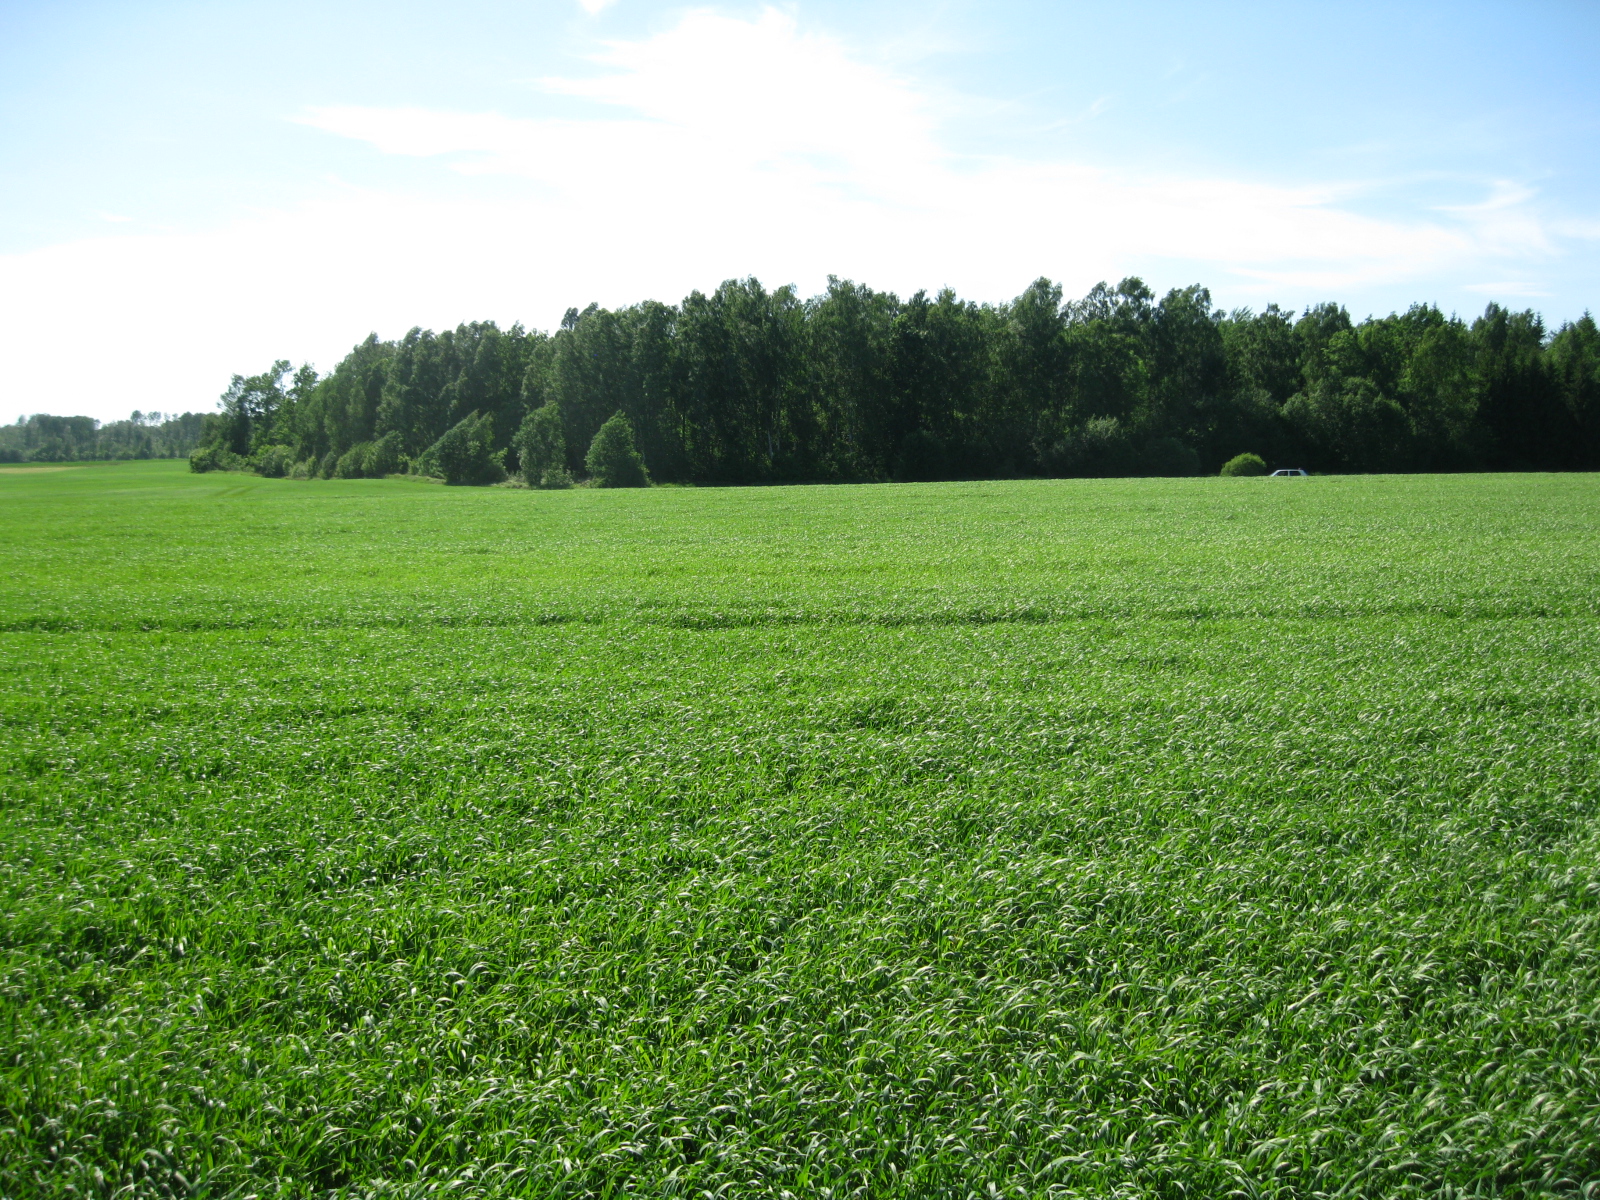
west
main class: Cropland
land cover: Barley
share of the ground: > 75 %
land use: Agriculture (excluding fallow land and kitchen gardens)
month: June
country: LT
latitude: 55.8533
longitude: 23.8383
